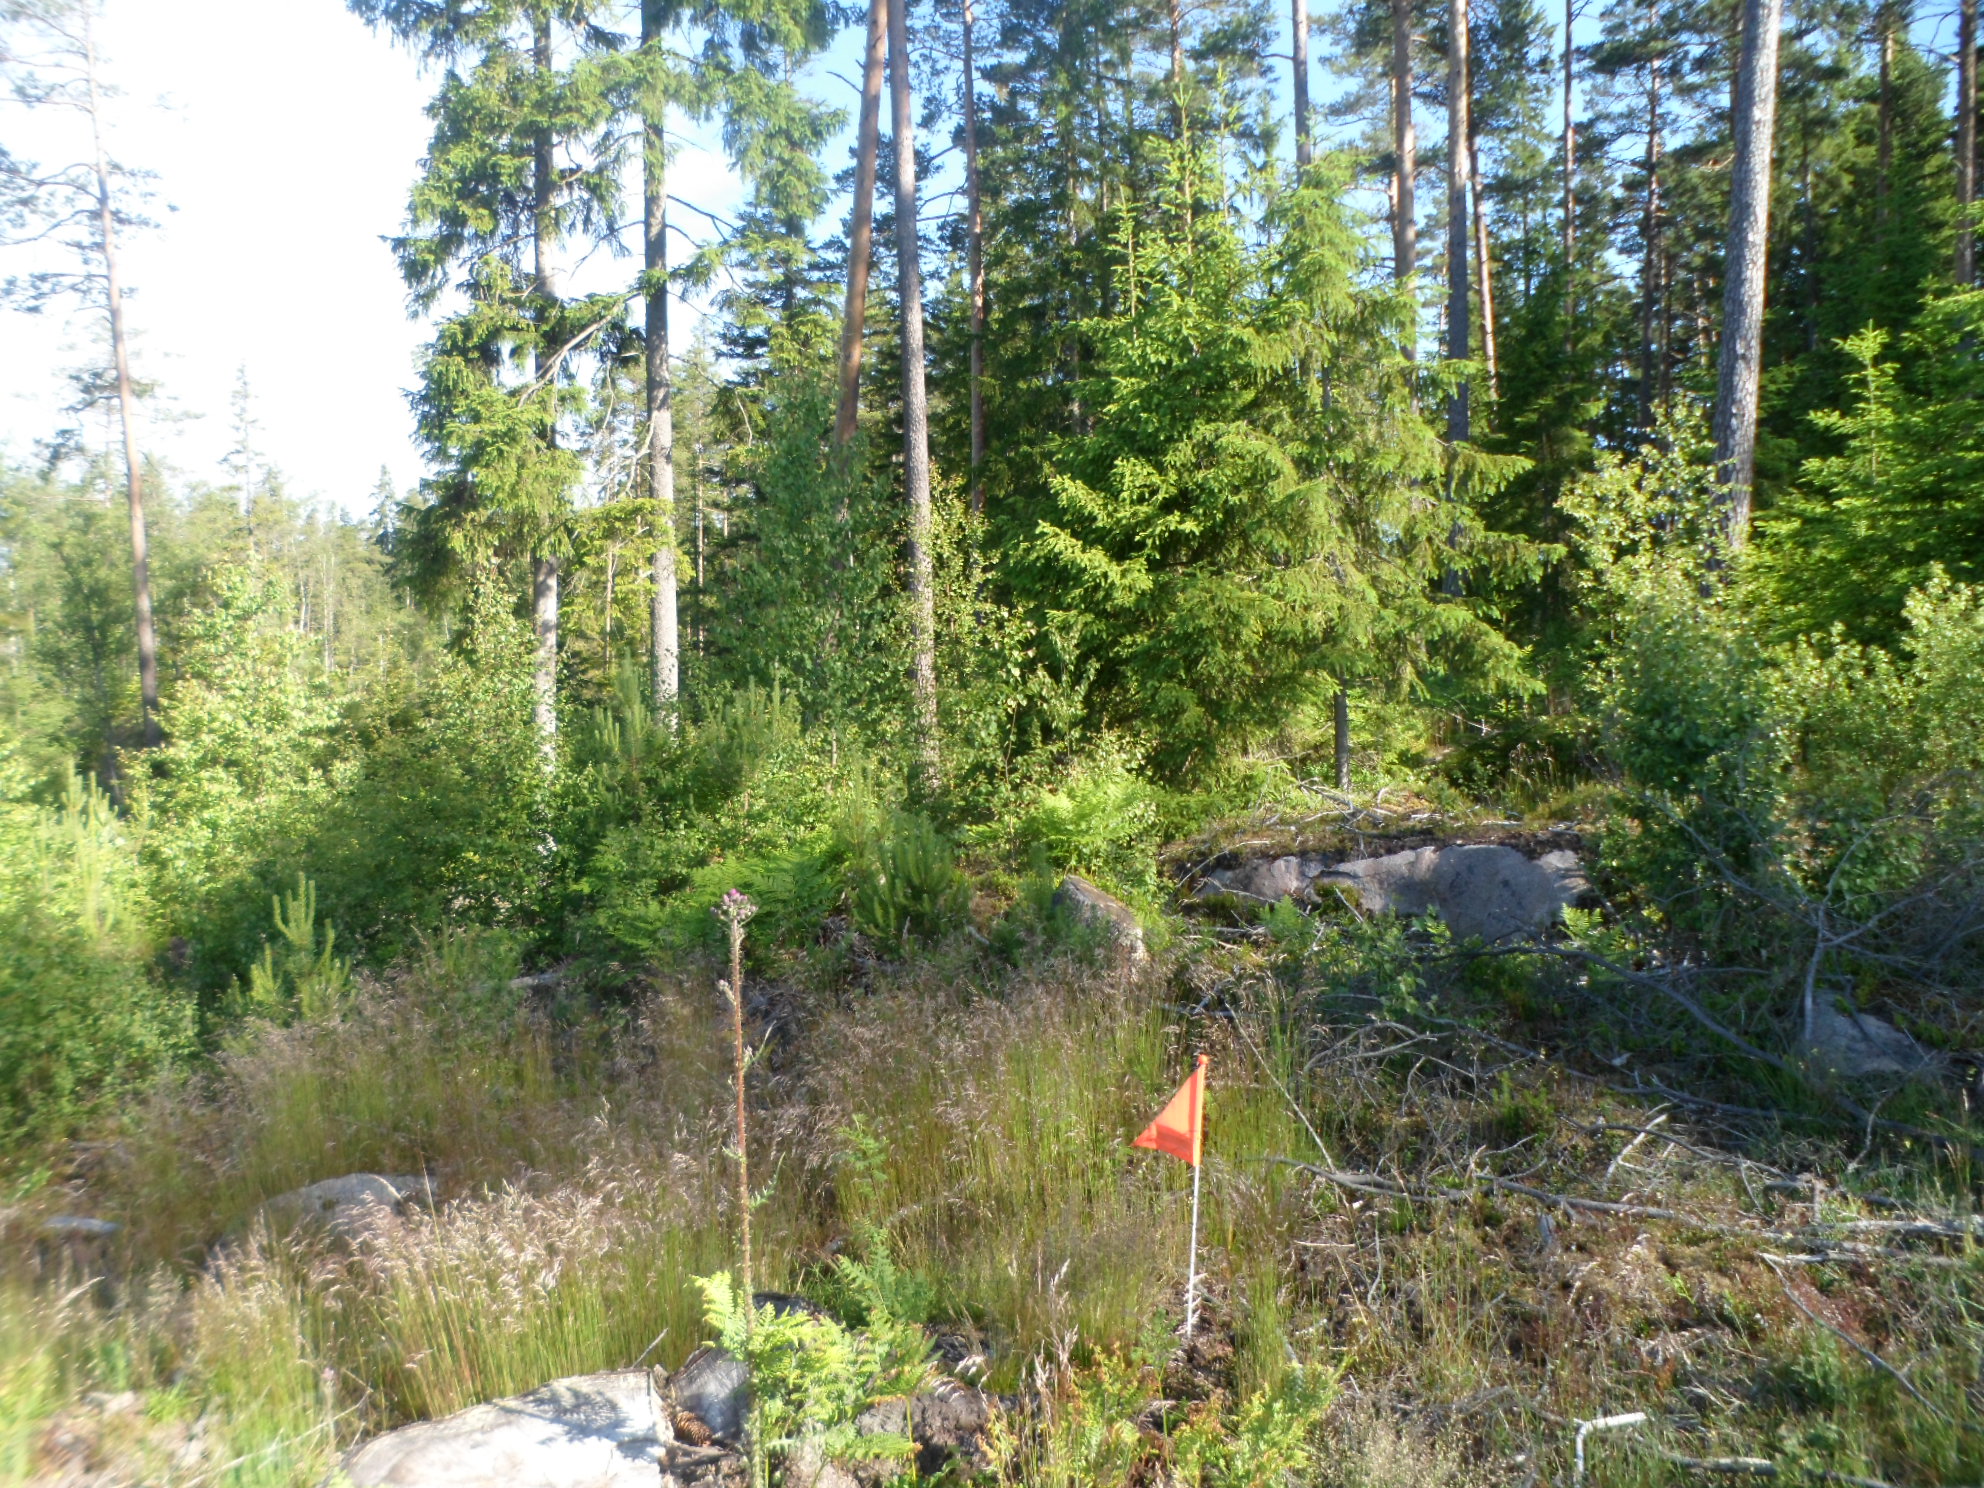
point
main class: Woodland
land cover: Pine dominated mixed woodland
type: boreal forest
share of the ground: 50 - 75 %
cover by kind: broadleaved forest trees 35 %, coniferous forest trees 25 %, herbaceous plants 25 %, shrubs 10 %, lichens and mosses 5 %
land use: Forestry
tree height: < 5 m
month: June
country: SE
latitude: 57.0617
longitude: 15.4890
